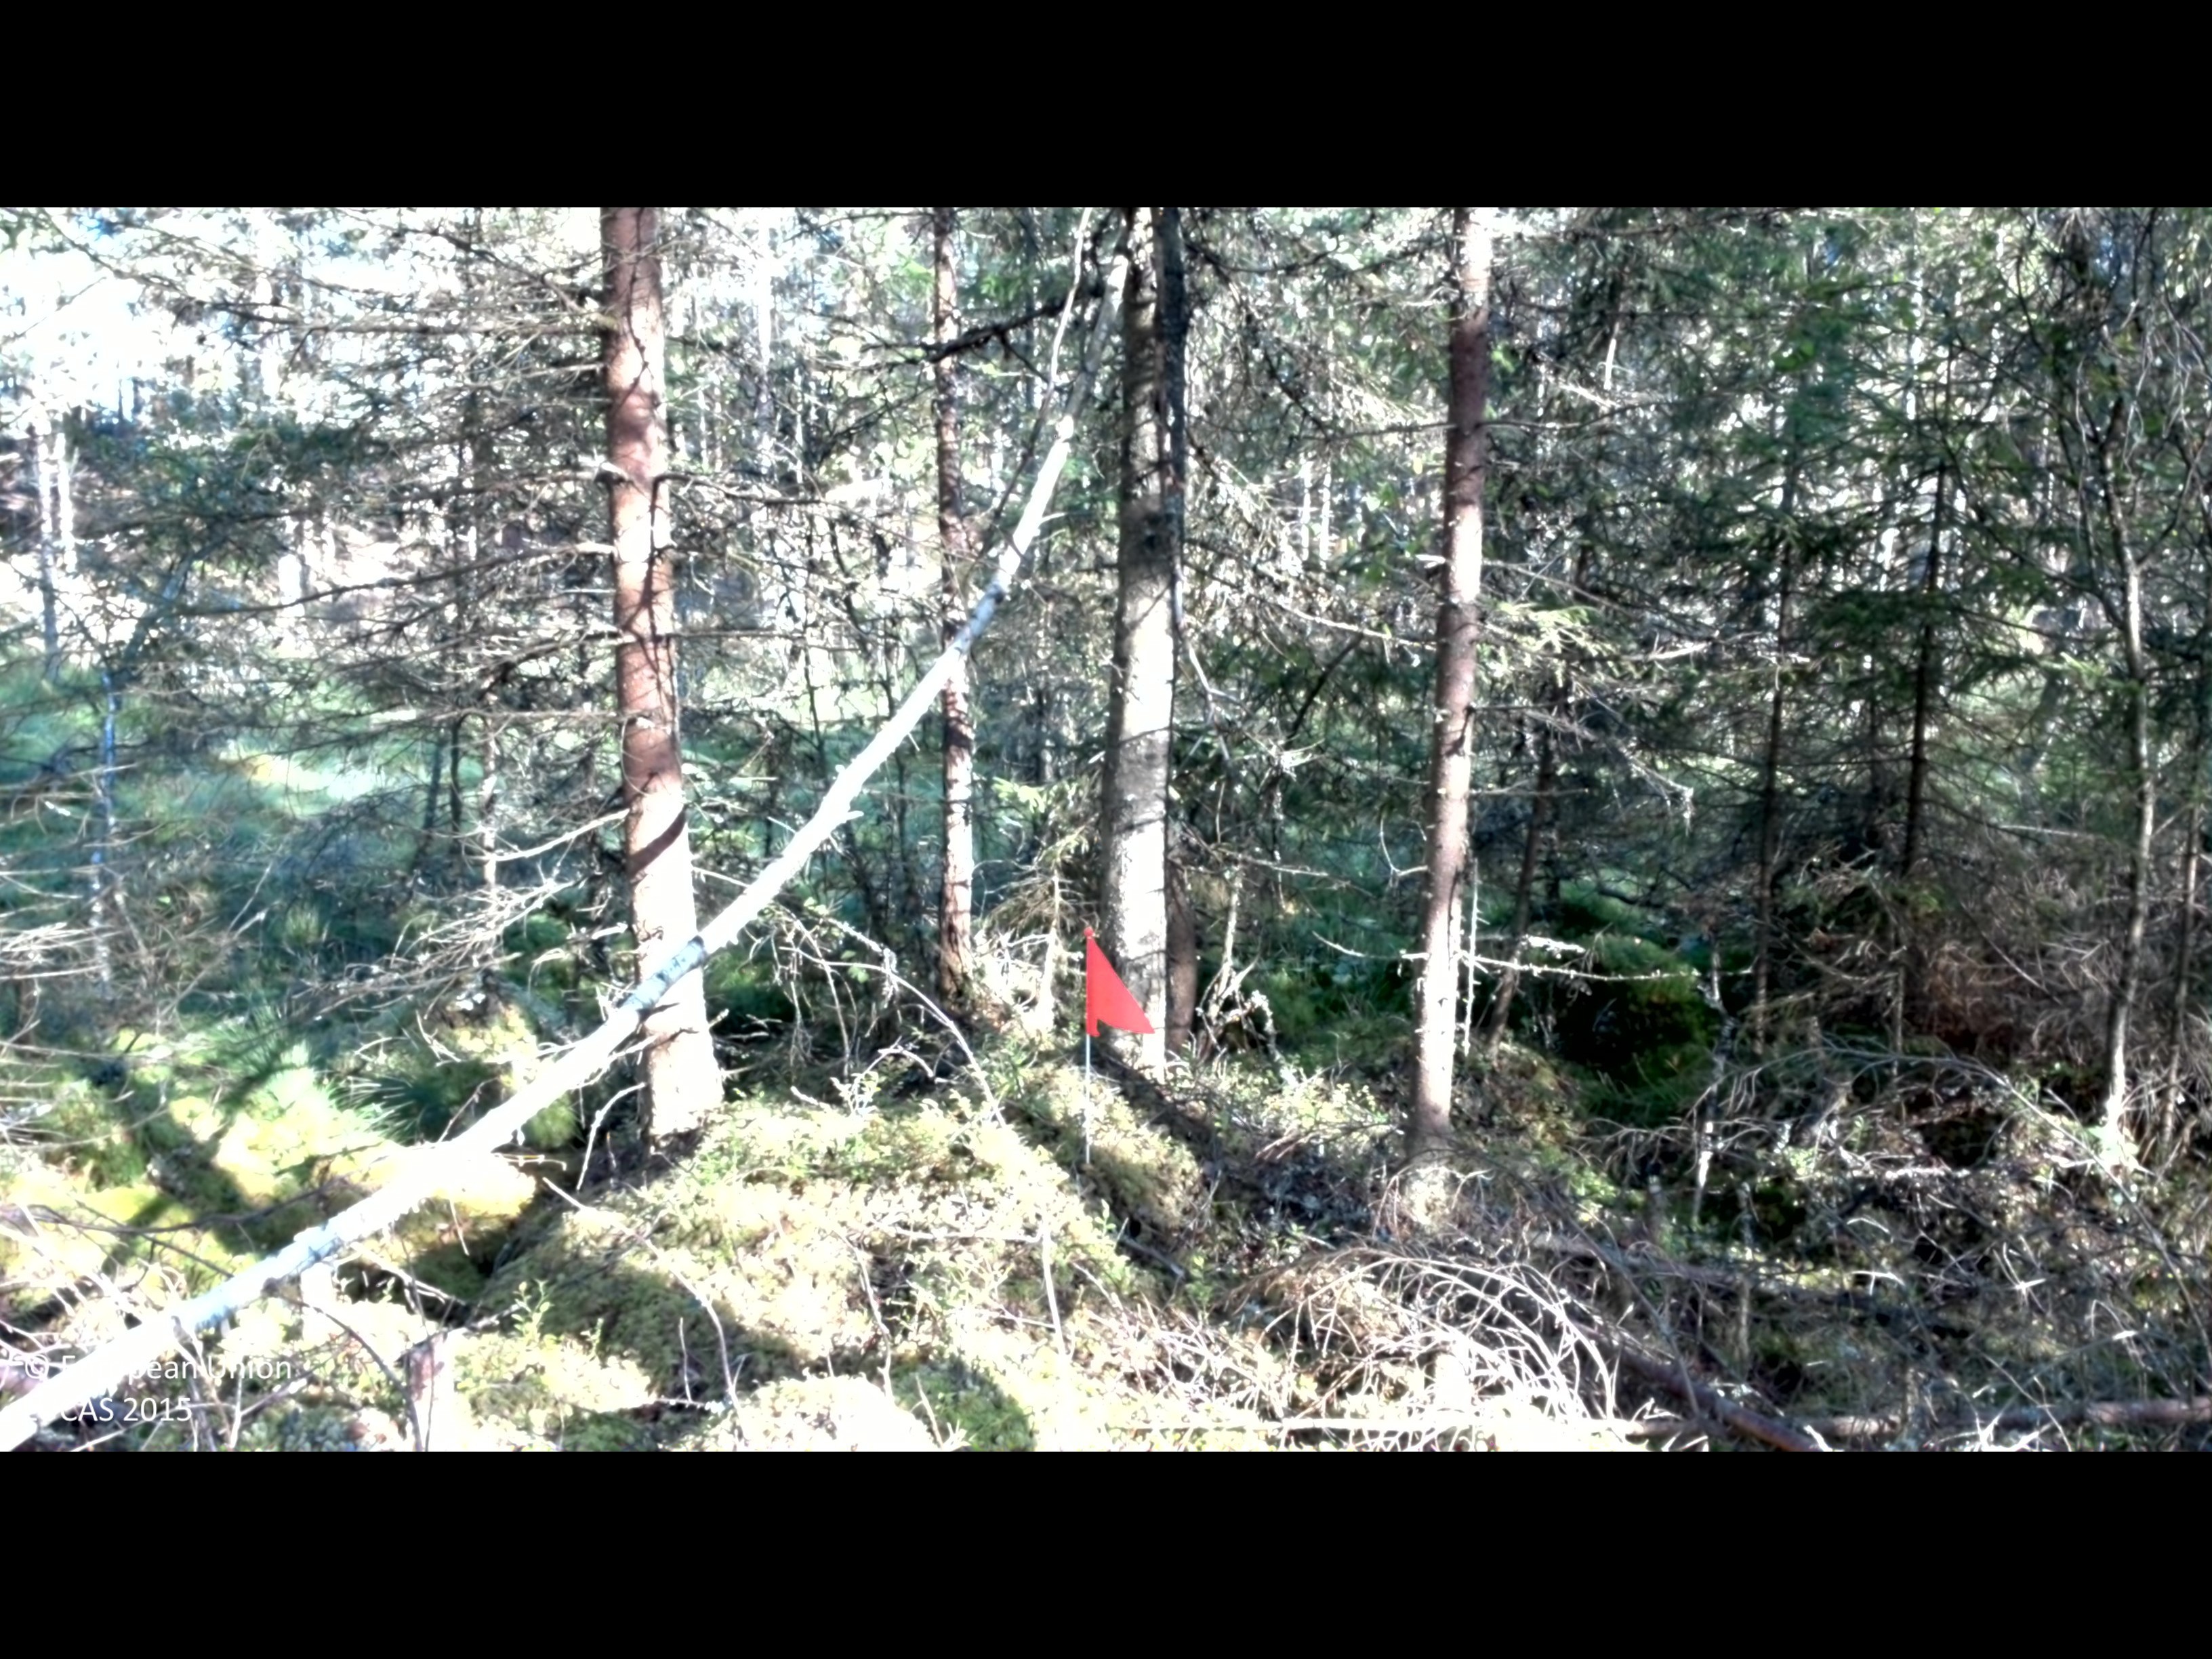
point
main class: Woodland
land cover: Spruce dominated mixed woodland
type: boreal forest
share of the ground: 50 - 75 %
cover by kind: coniferous forest trees 45 %, broadleaved forest trees 30 %, shrubs 10 %, lichens and mosses 10 %, herbaceous plants 5 %
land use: Forestry
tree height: > 5 m
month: September
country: SE
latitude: 57.0832
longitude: 13.2137
